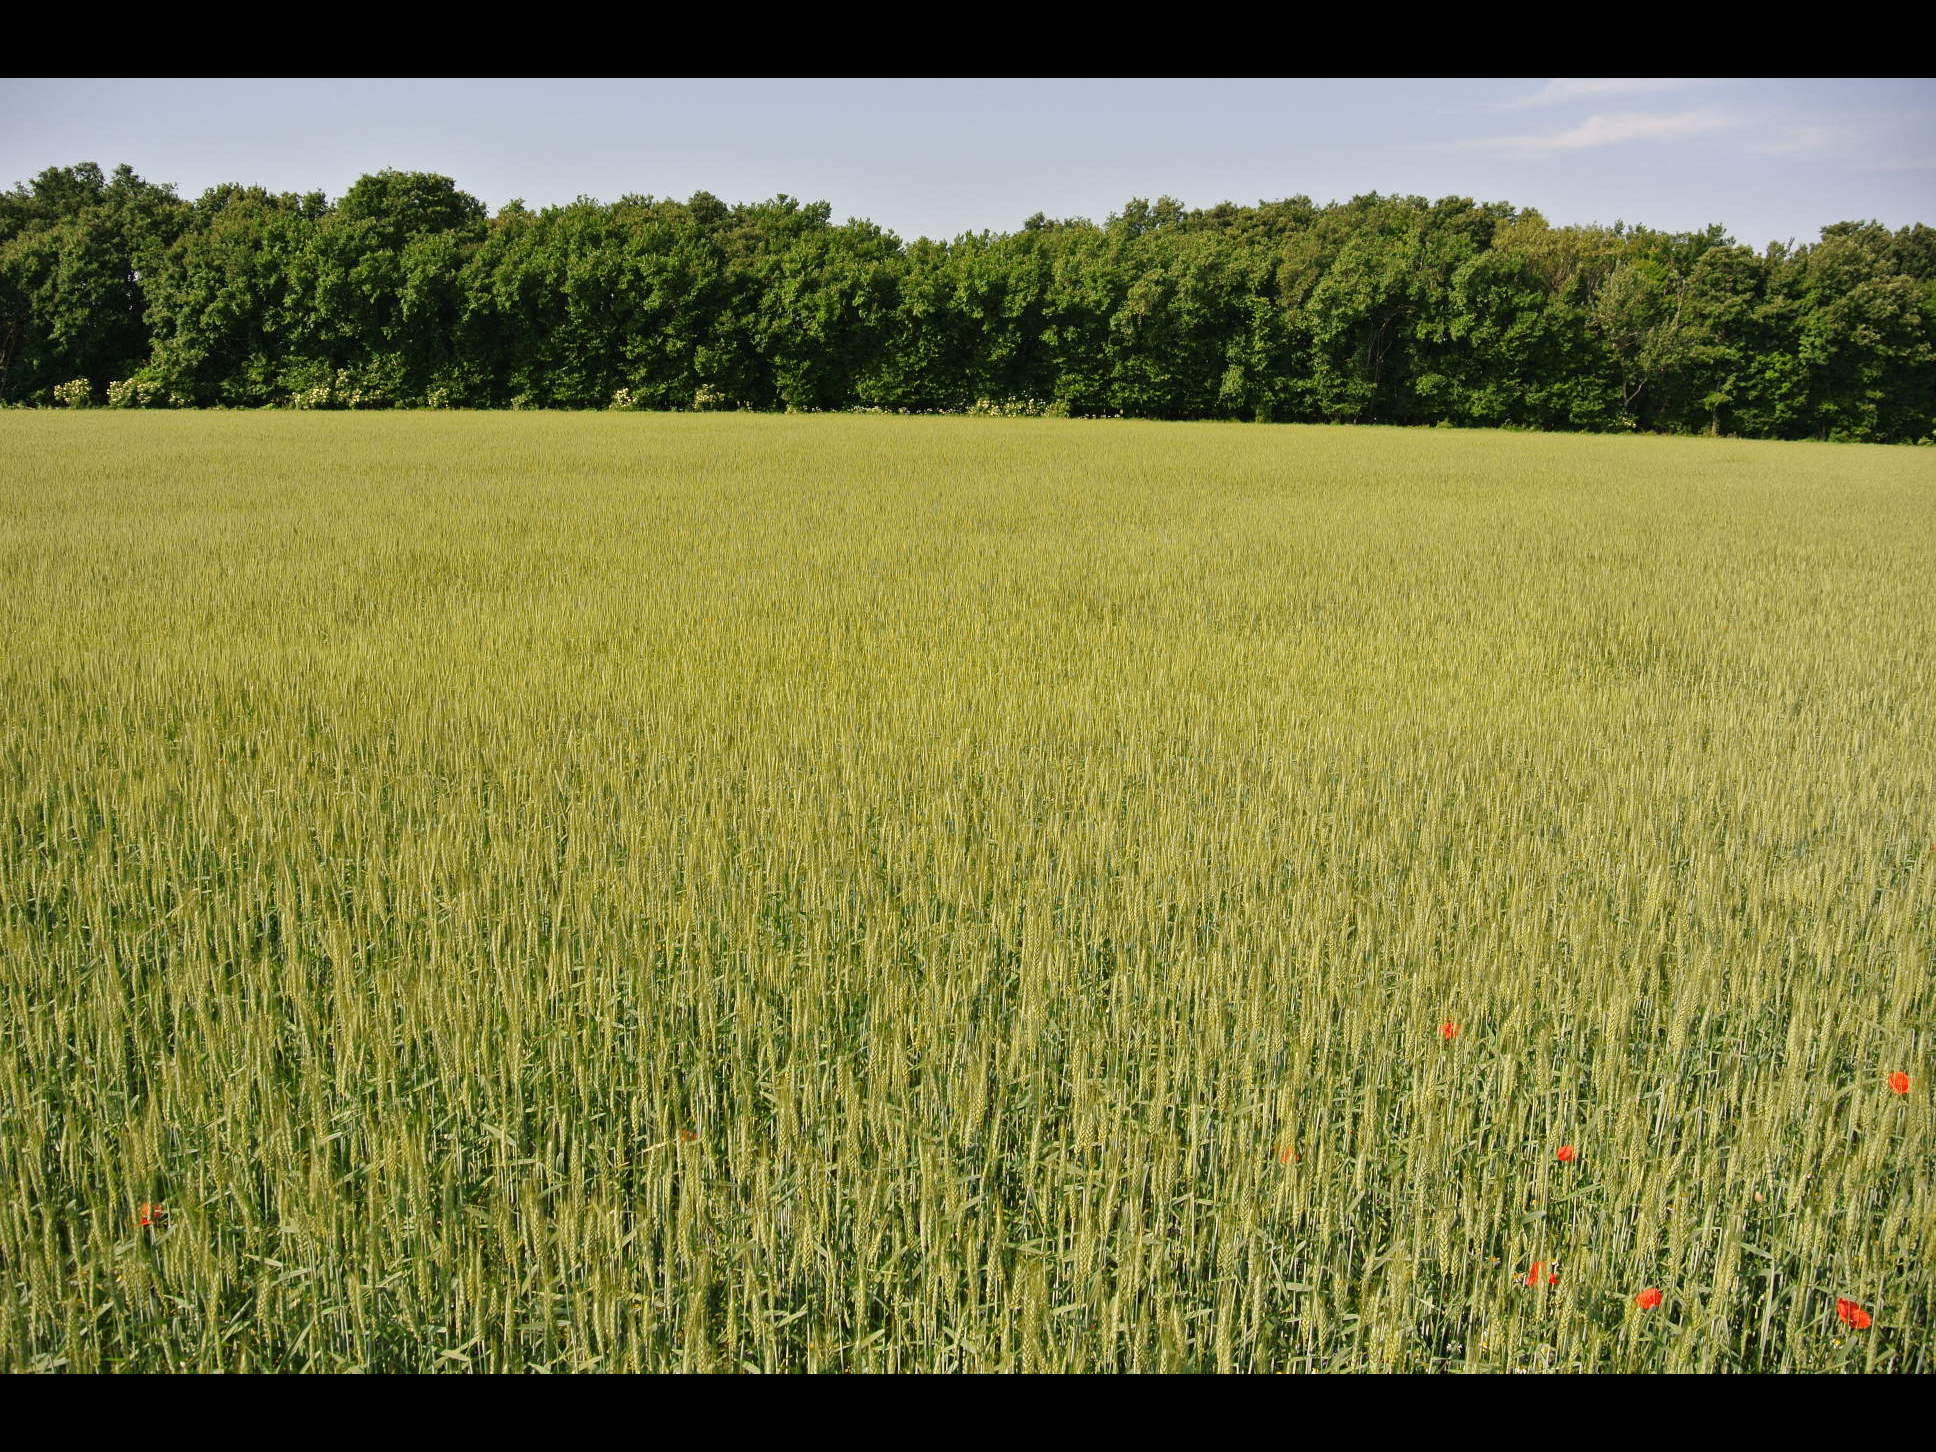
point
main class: Cropland
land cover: Common wheat
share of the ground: > 75 %
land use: Agriculture (excluding fallow land and kitchen gardens)
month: May
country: AT
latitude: 47.9595
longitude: 16.5001
